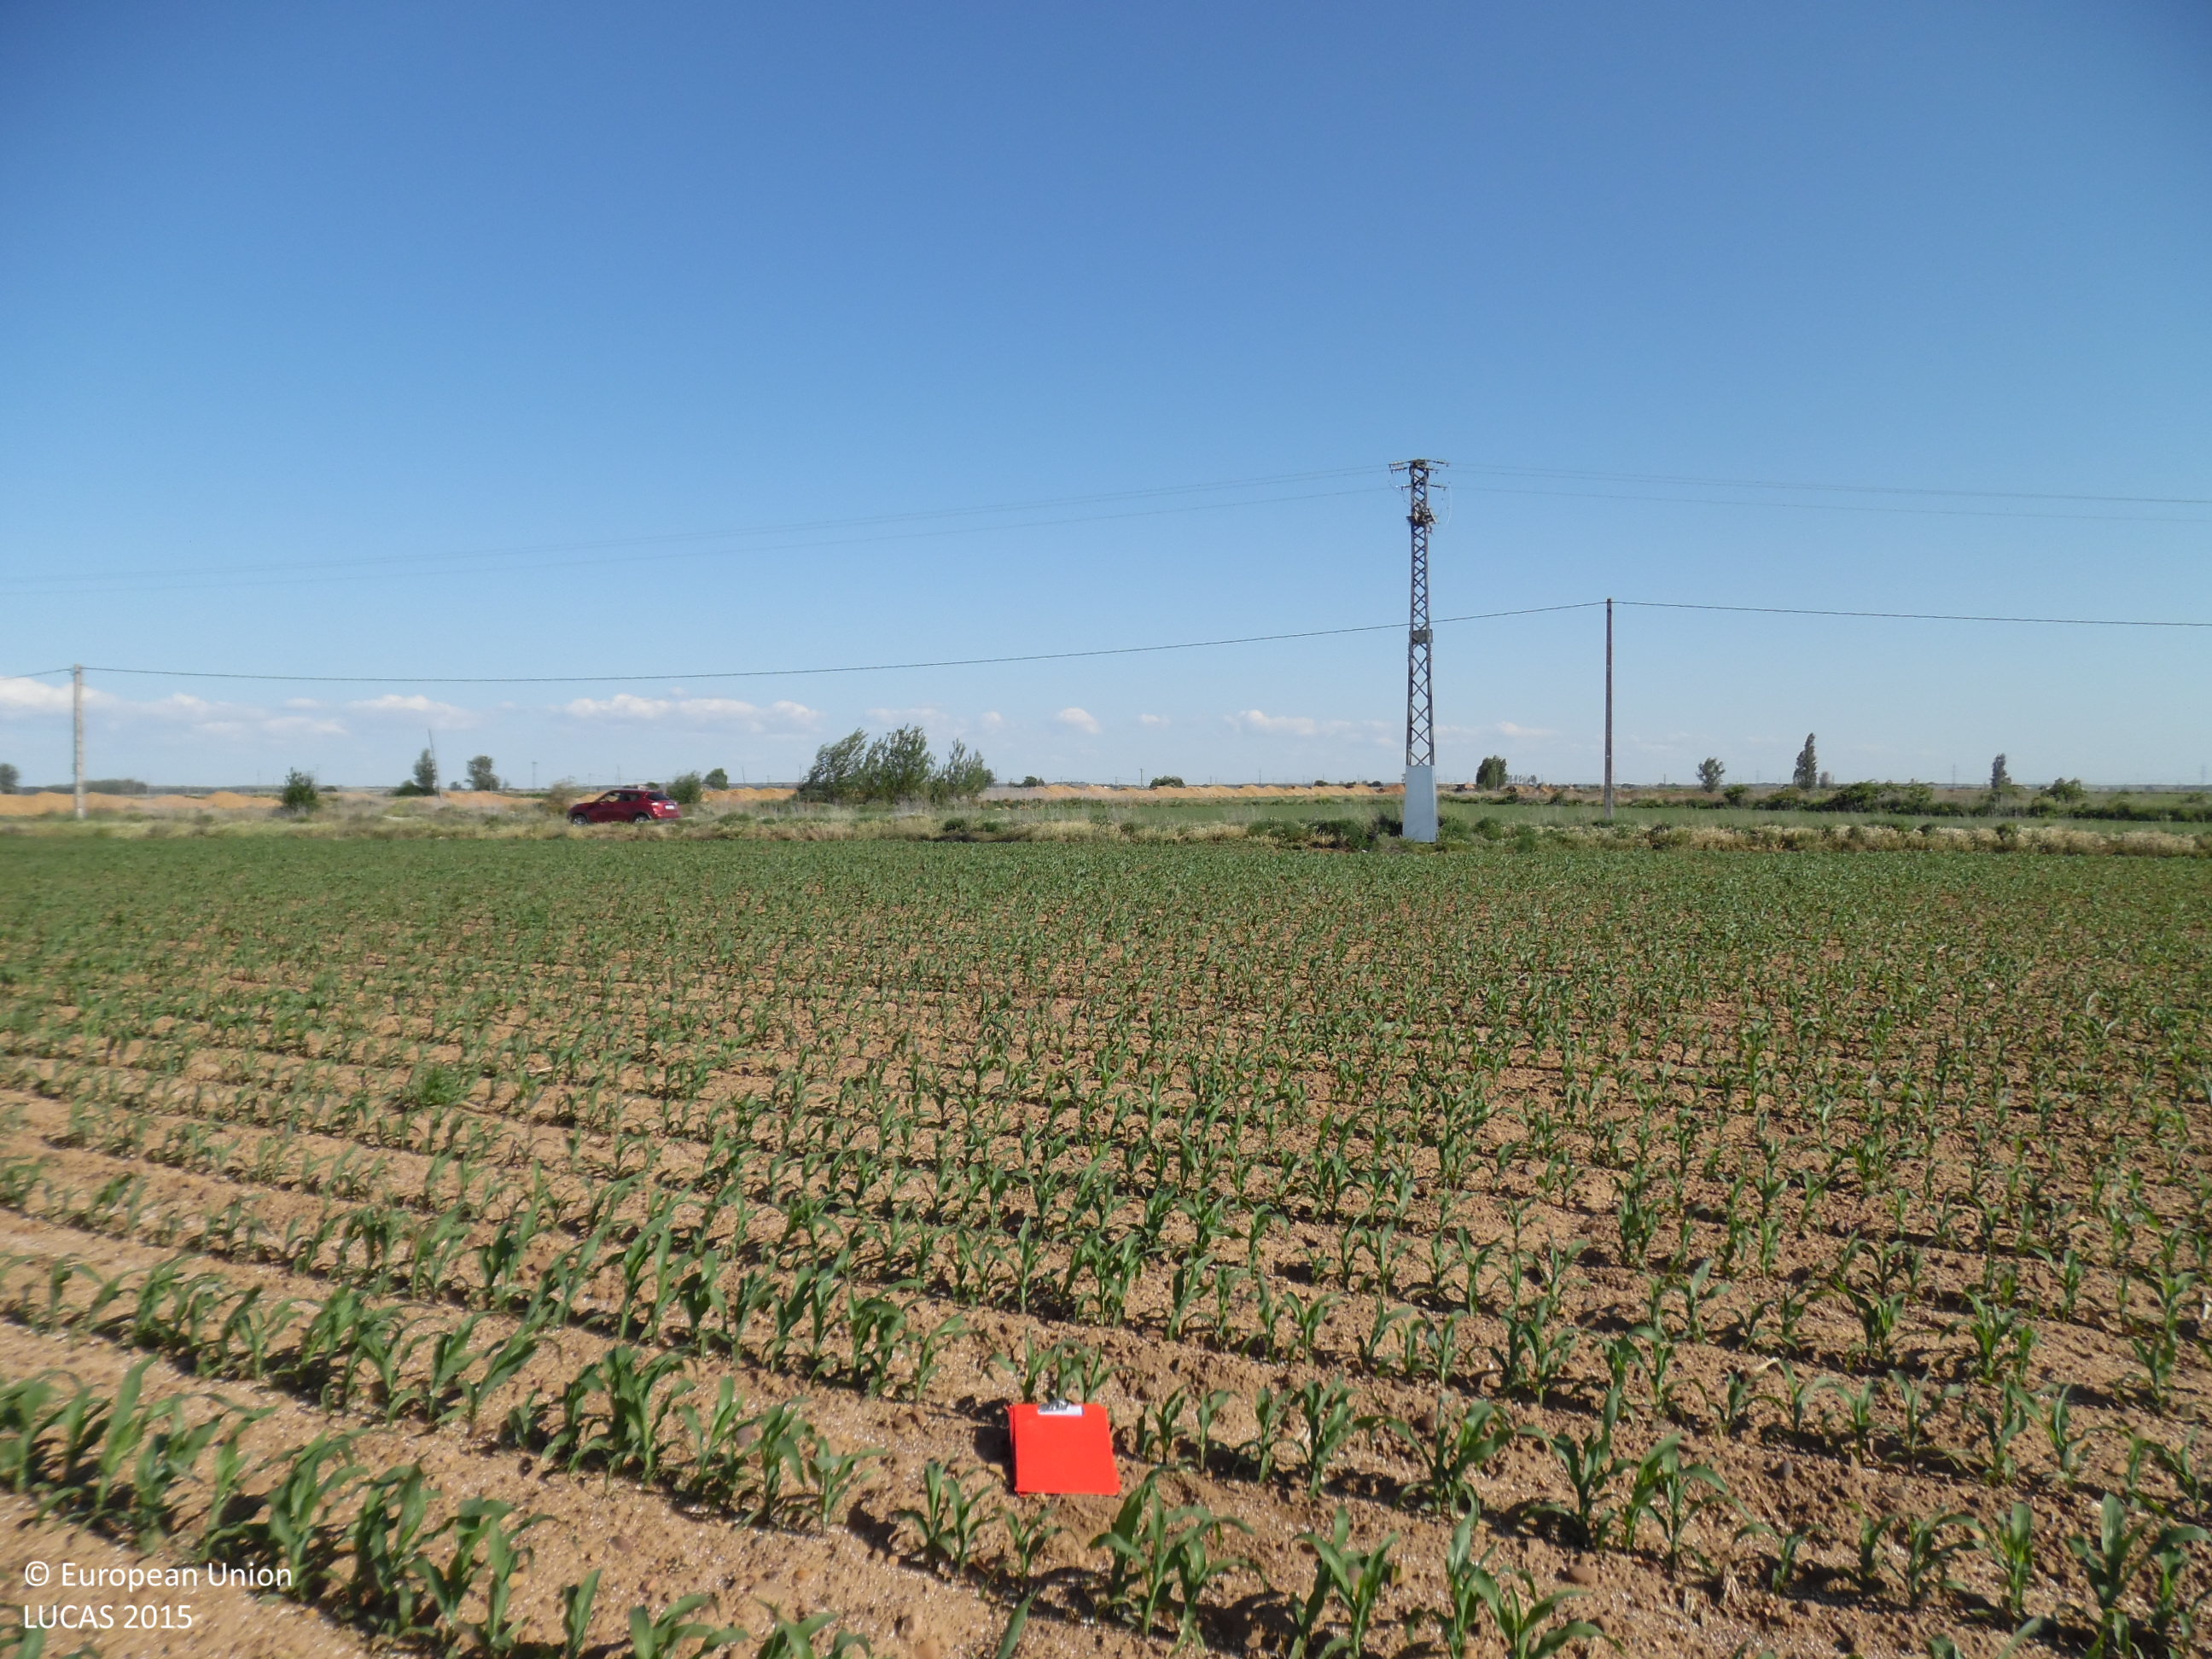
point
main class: Cropland
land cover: Maize
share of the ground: < 10 %
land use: Agriculture (excluding fallow land and kitchen gardens)
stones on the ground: < 10 %
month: May
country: ES
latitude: 42.2305
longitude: -5.6891
